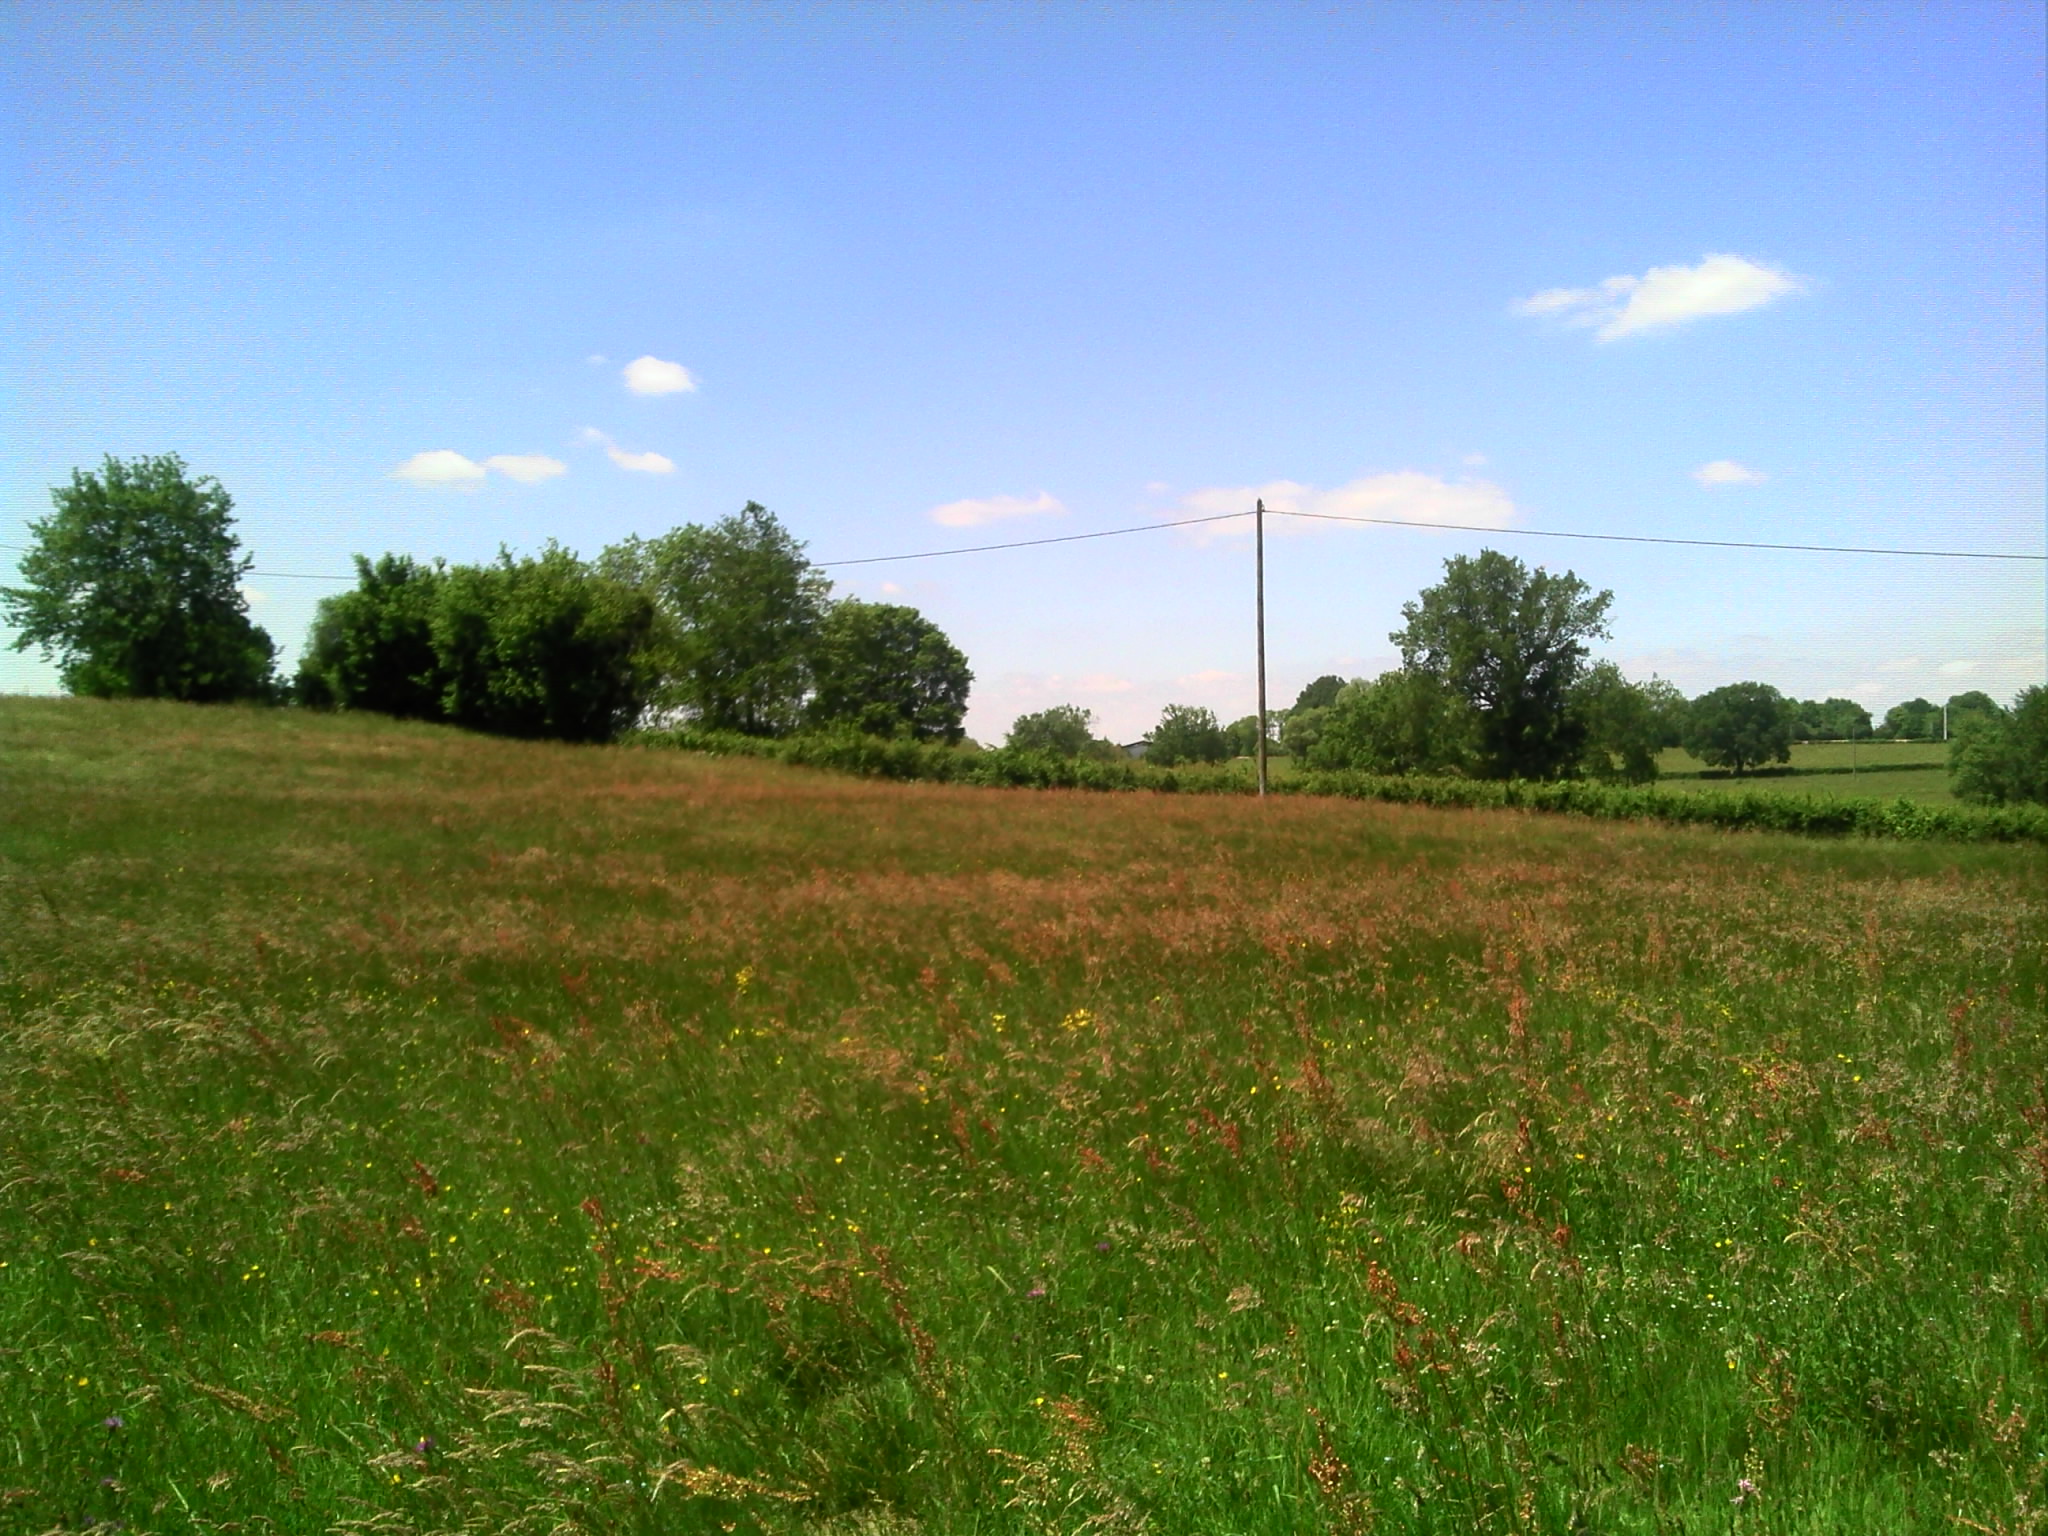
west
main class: Grassland
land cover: Grassland without tree/shrub cover
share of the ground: > 75 %
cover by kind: herbaceous plants 100 %
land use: Agriculture (excluding fallow land and kitchen gardens)
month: May
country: FR
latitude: 46.5115
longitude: 5.1409
